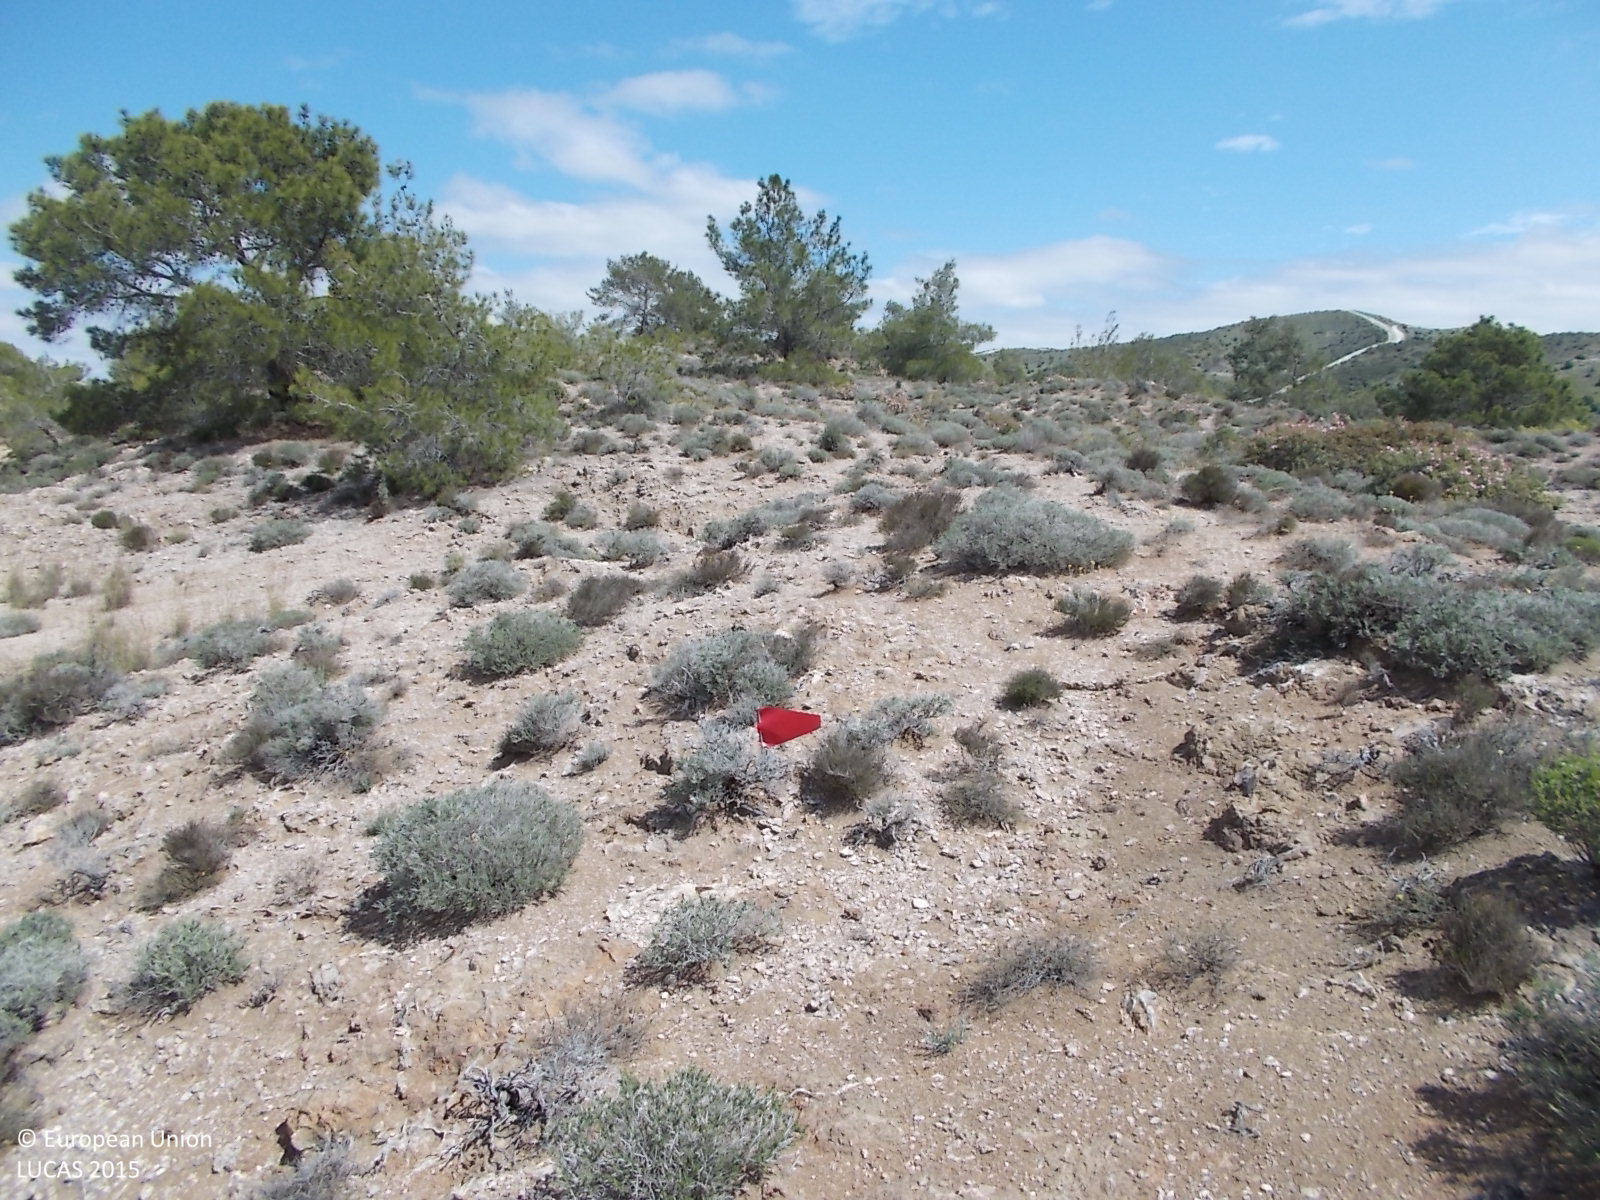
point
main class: Shrubland
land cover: Shrubland without tree cover
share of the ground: 25 - 50 %
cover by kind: shrubs 50 %, unconsolidated bare surface 50 %
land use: Semi-natural and natural areas not in use
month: April
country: CY
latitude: 34.8816
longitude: 33.4598
